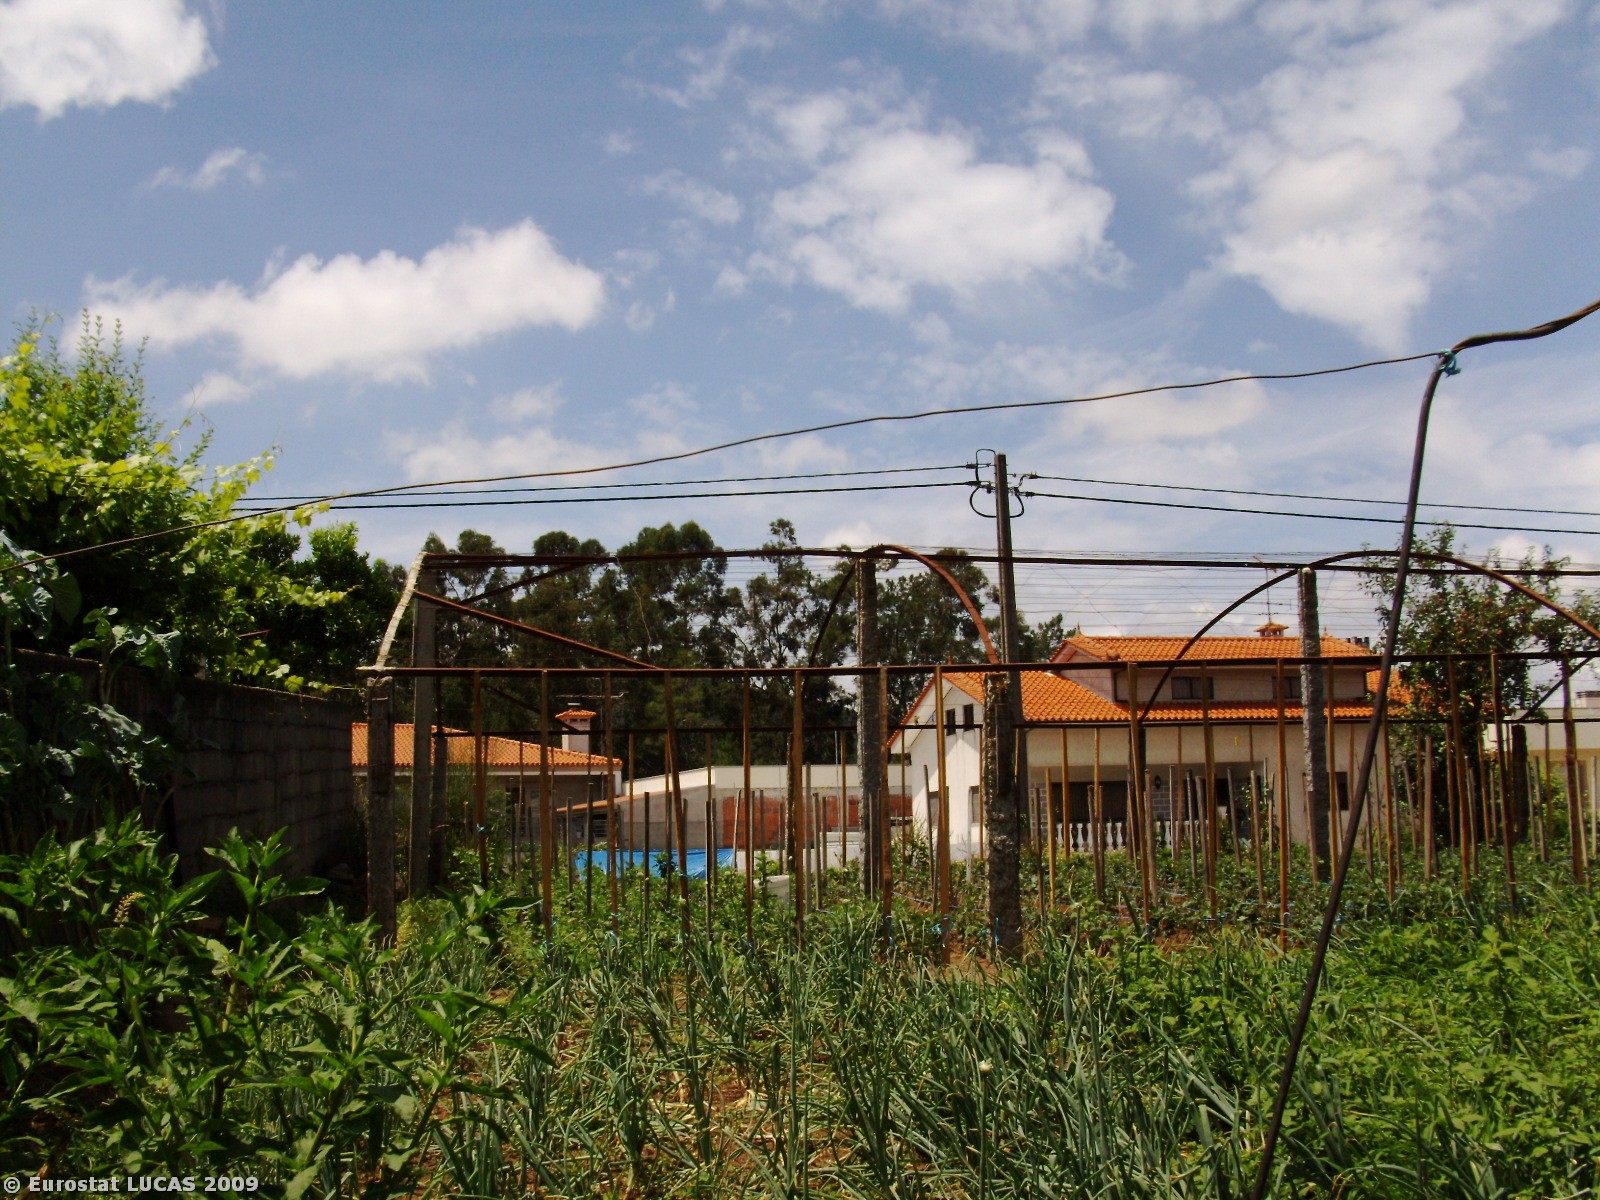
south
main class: Artificial land
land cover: Greenhouses
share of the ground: 25 - 50 %
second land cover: Nurseries
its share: 25 - 50 %
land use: Kitchen garden
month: June
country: PT
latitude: 41.4923
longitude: -8.5674
